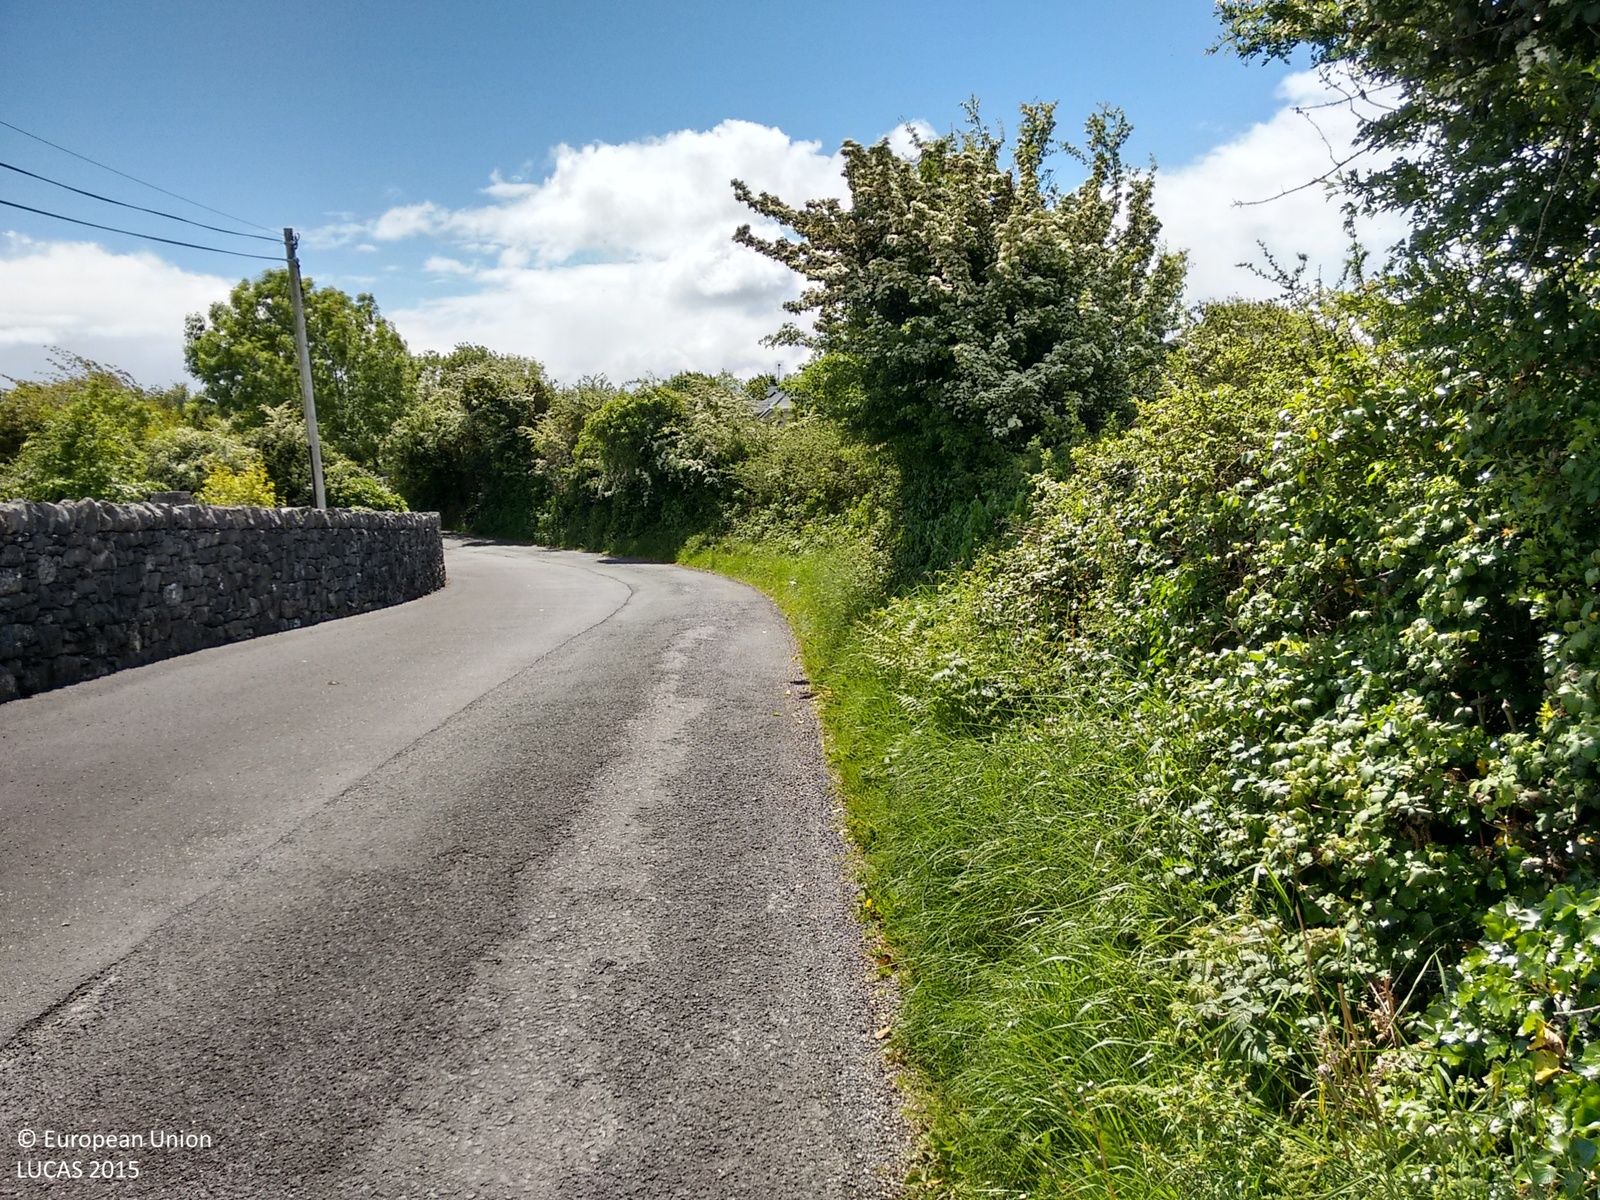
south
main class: Grassland
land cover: Grassland without tree/shrub cover
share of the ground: > 75 %
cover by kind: herbaceous plants 95 %, shrubs 5 %
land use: Agriculture (excluding fallow land and kitchen gardens)
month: May
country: IE
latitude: 53.4076
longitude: -9.0322
